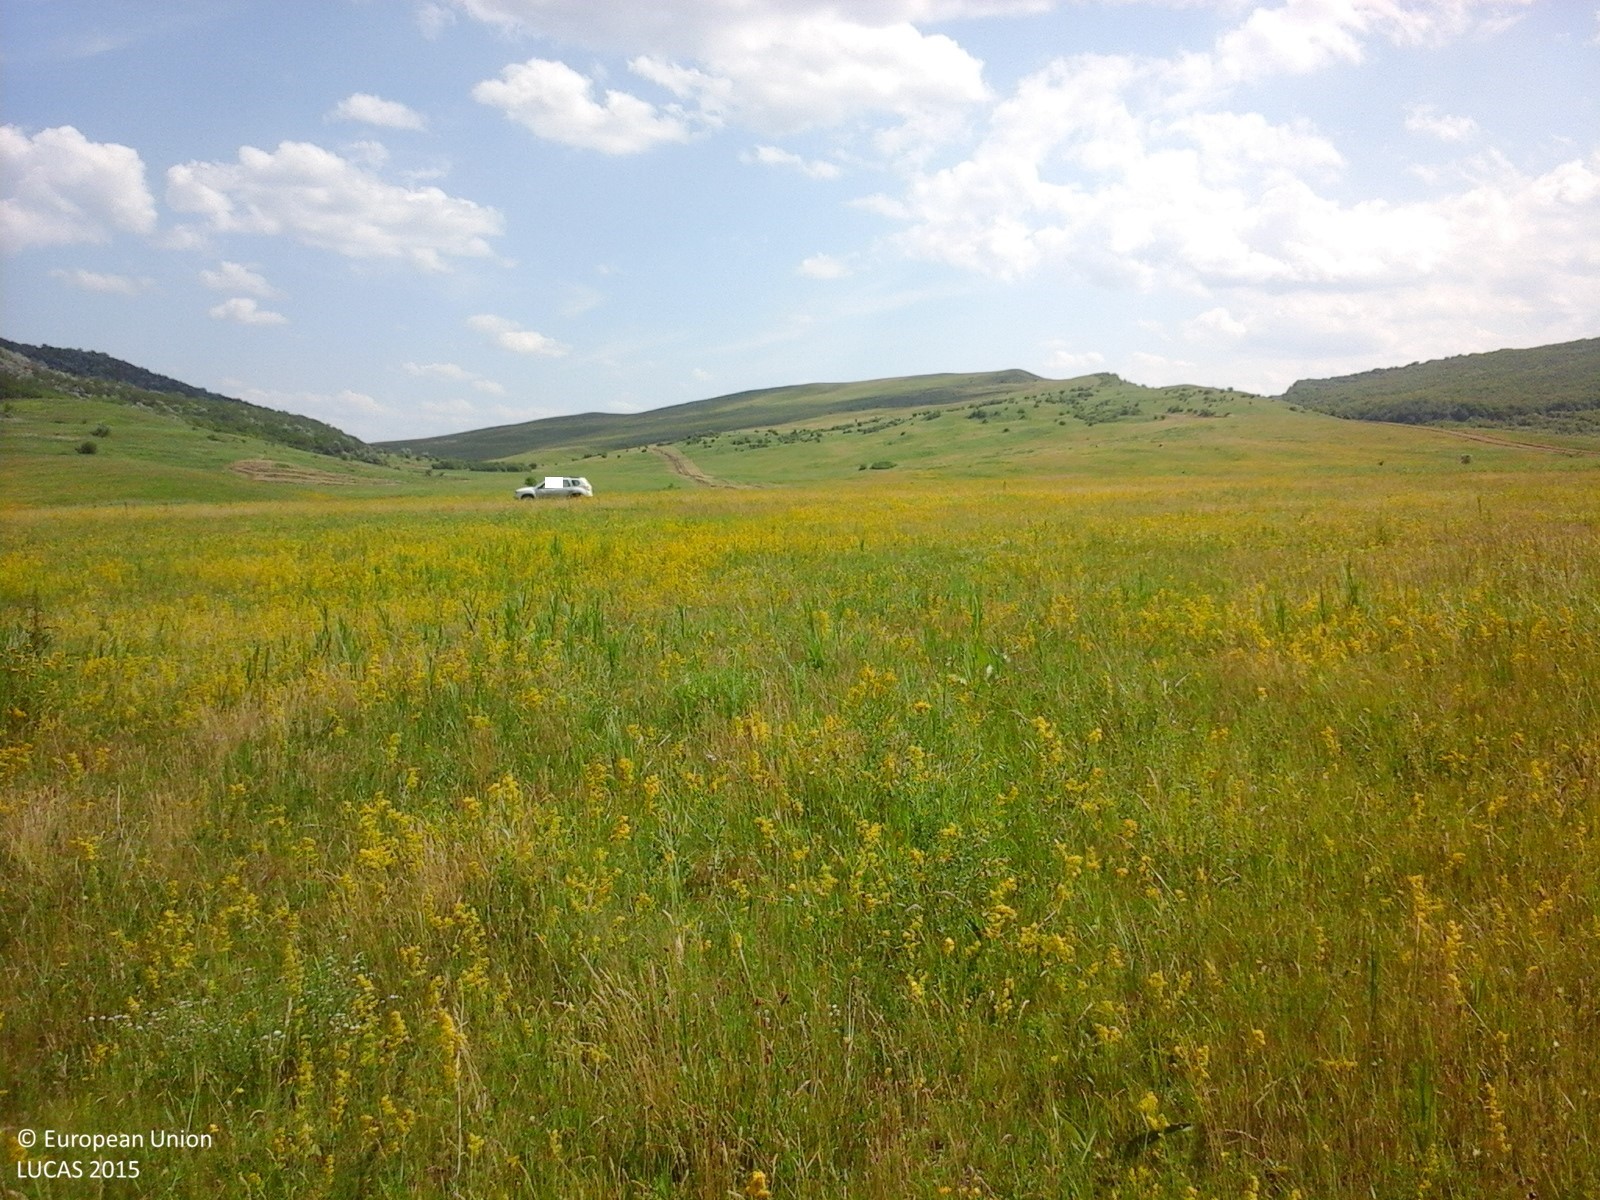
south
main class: Grassland
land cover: Grassland without tree/shrub cover
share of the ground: > 75 %
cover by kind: herbaceous plants 100 %
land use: Agriculture (excluding fallow land and kitchen gardens)
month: June
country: RO
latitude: 47.9068
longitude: 26.3696
